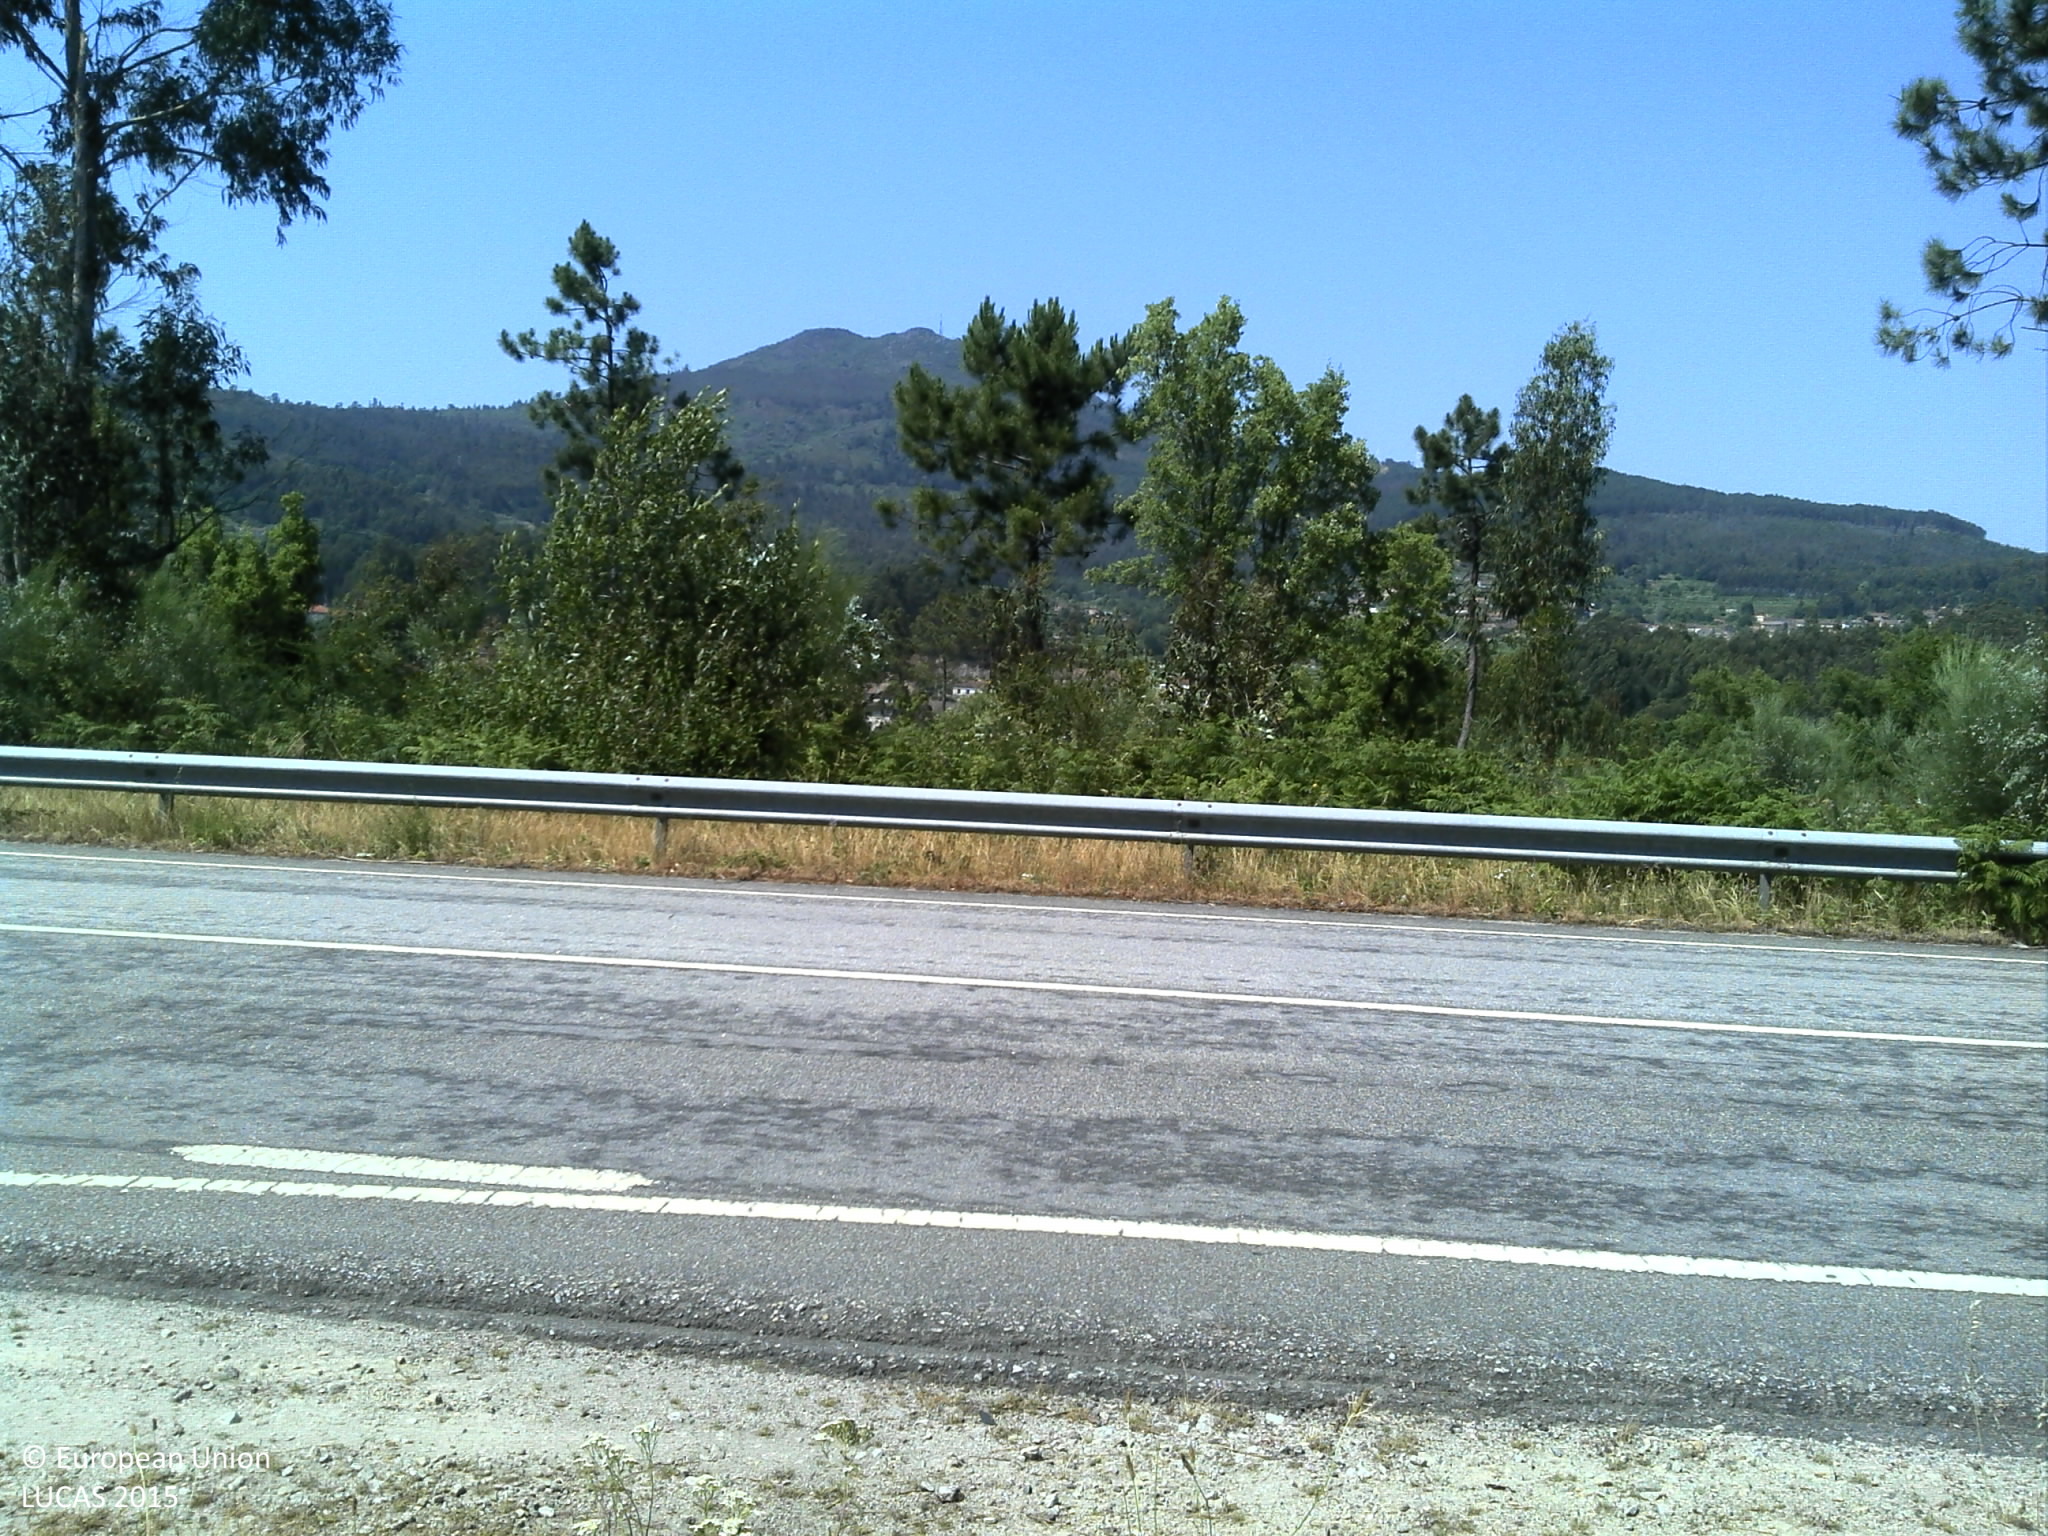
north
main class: Shrubland
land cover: Shrubland with sparse tree cover
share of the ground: > 75 %
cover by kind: shrubs 85 %, broadleaved forest trees 5 %, consolidated bare surface 5 %, unconsolidated bare surface 5 %
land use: Forestry
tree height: > 5 m
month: June
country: PT
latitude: 42.0865
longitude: -8.3546
